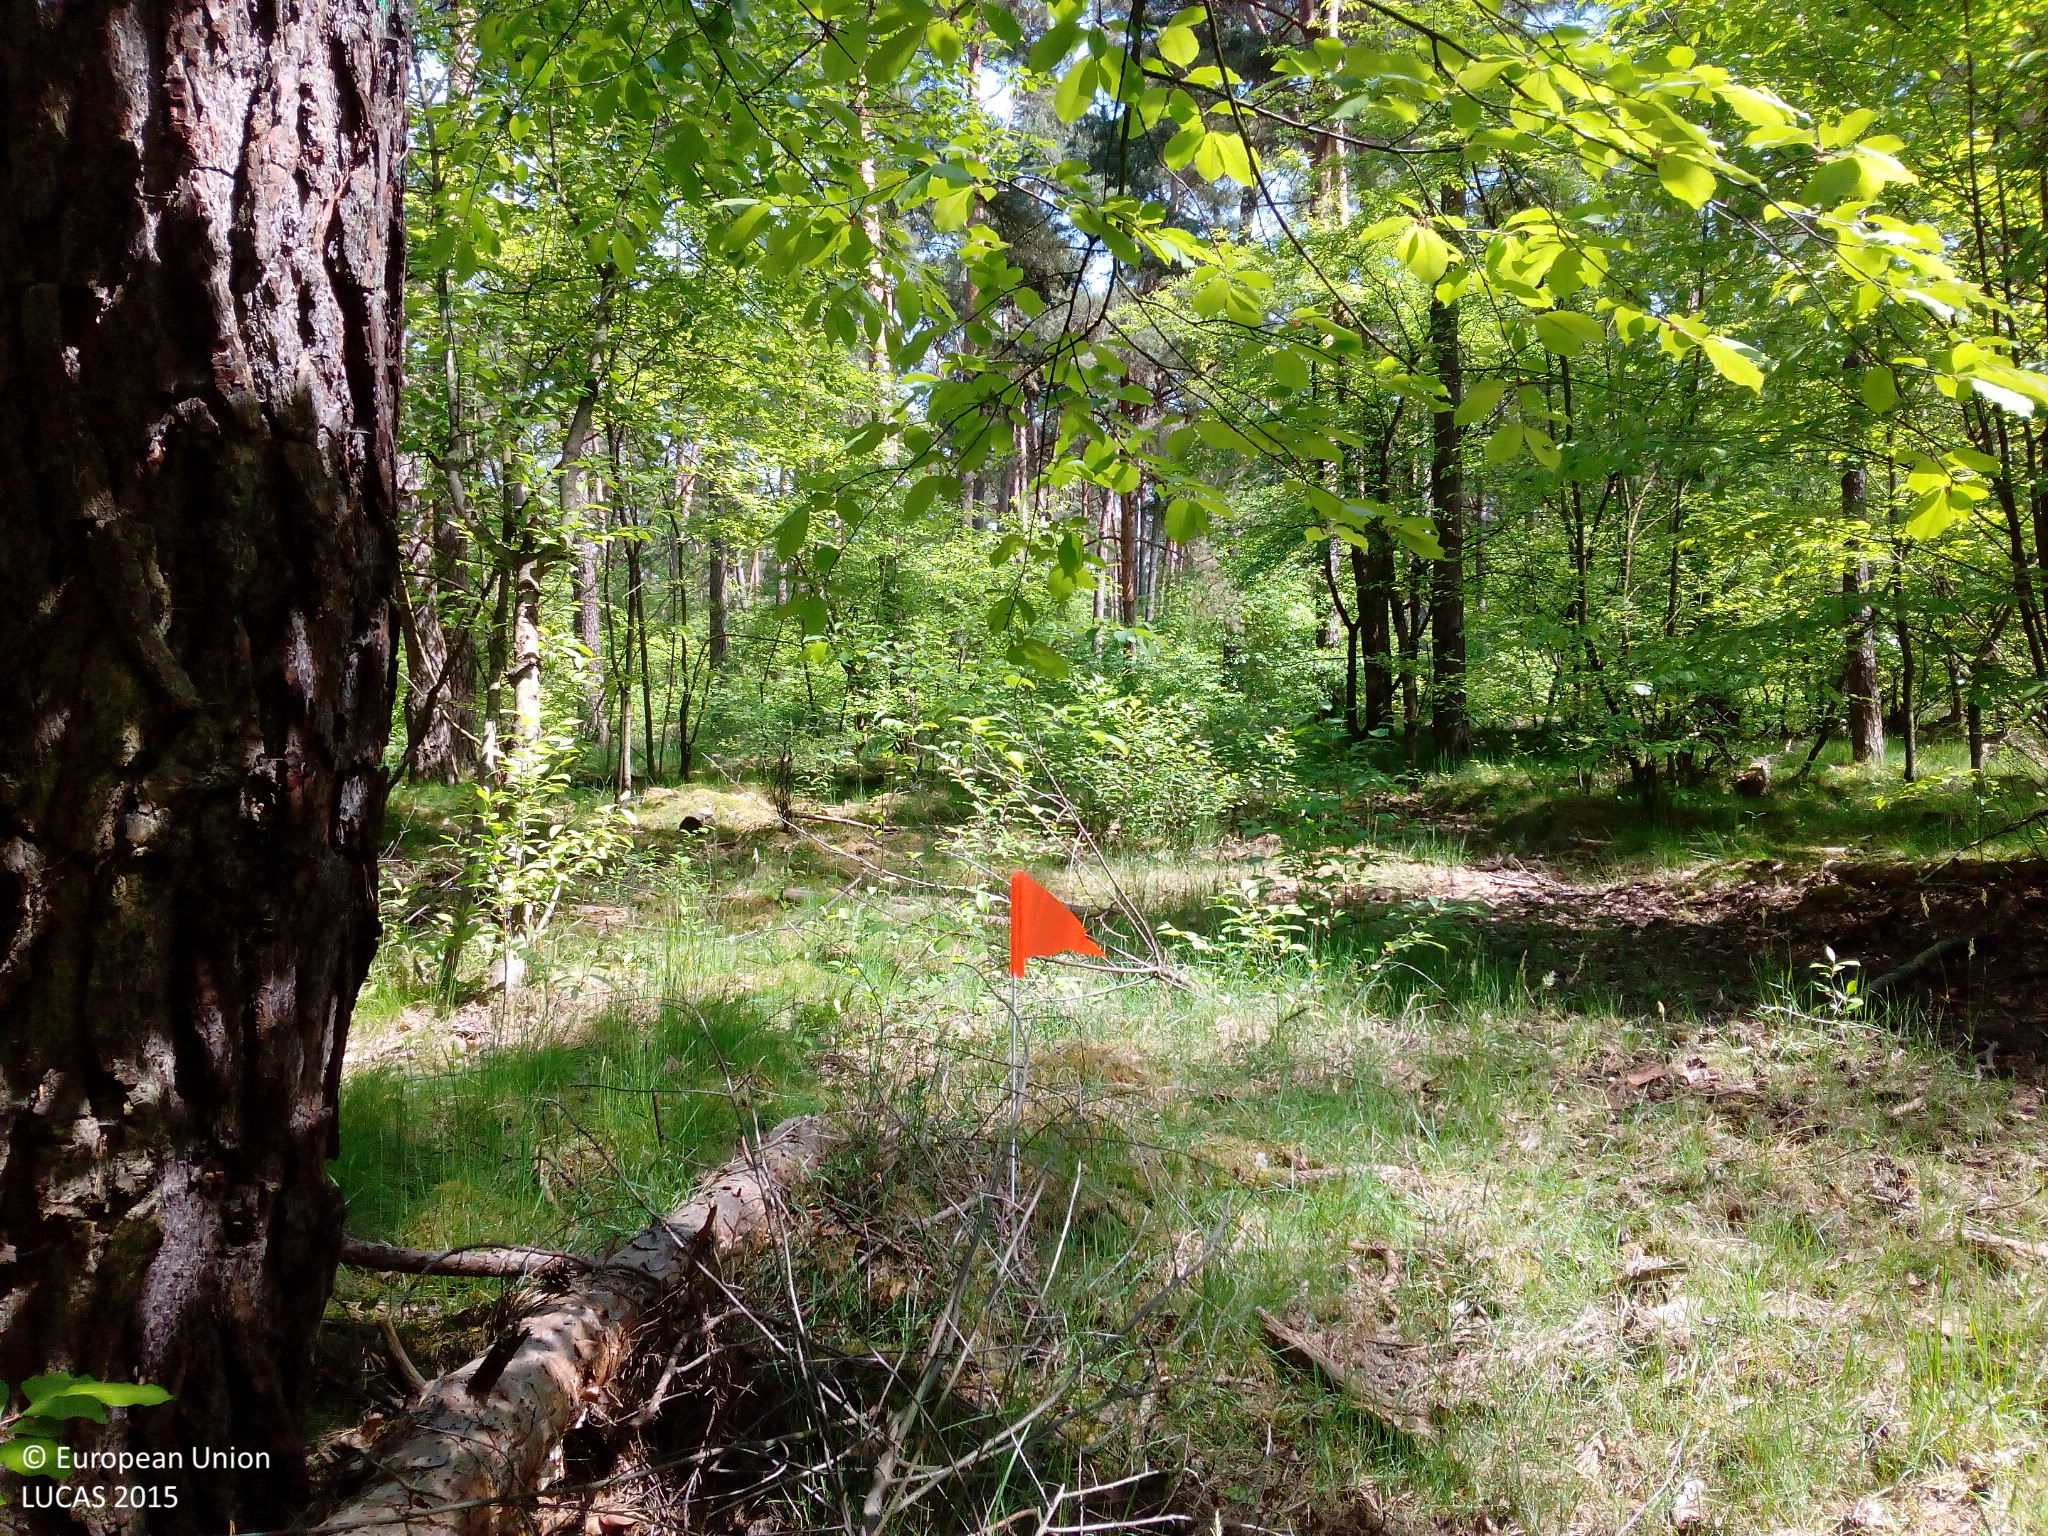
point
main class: Woodland
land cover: Pine dominated mixed woodland
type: hemiboreal forest and nemoral coniferous forest and mixed broadleaved-coniferous forest
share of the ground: 50 - 75 %
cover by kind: coniferous forest trees 40 %, broadleaved forest trees 25 %, herbaceous plants 20 %, unconsolidated bare surface 10 %, shrubs 5 %
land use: Forestry
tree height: > 5 m
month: May
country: DE
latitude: 49.5811
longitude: 8.5205
